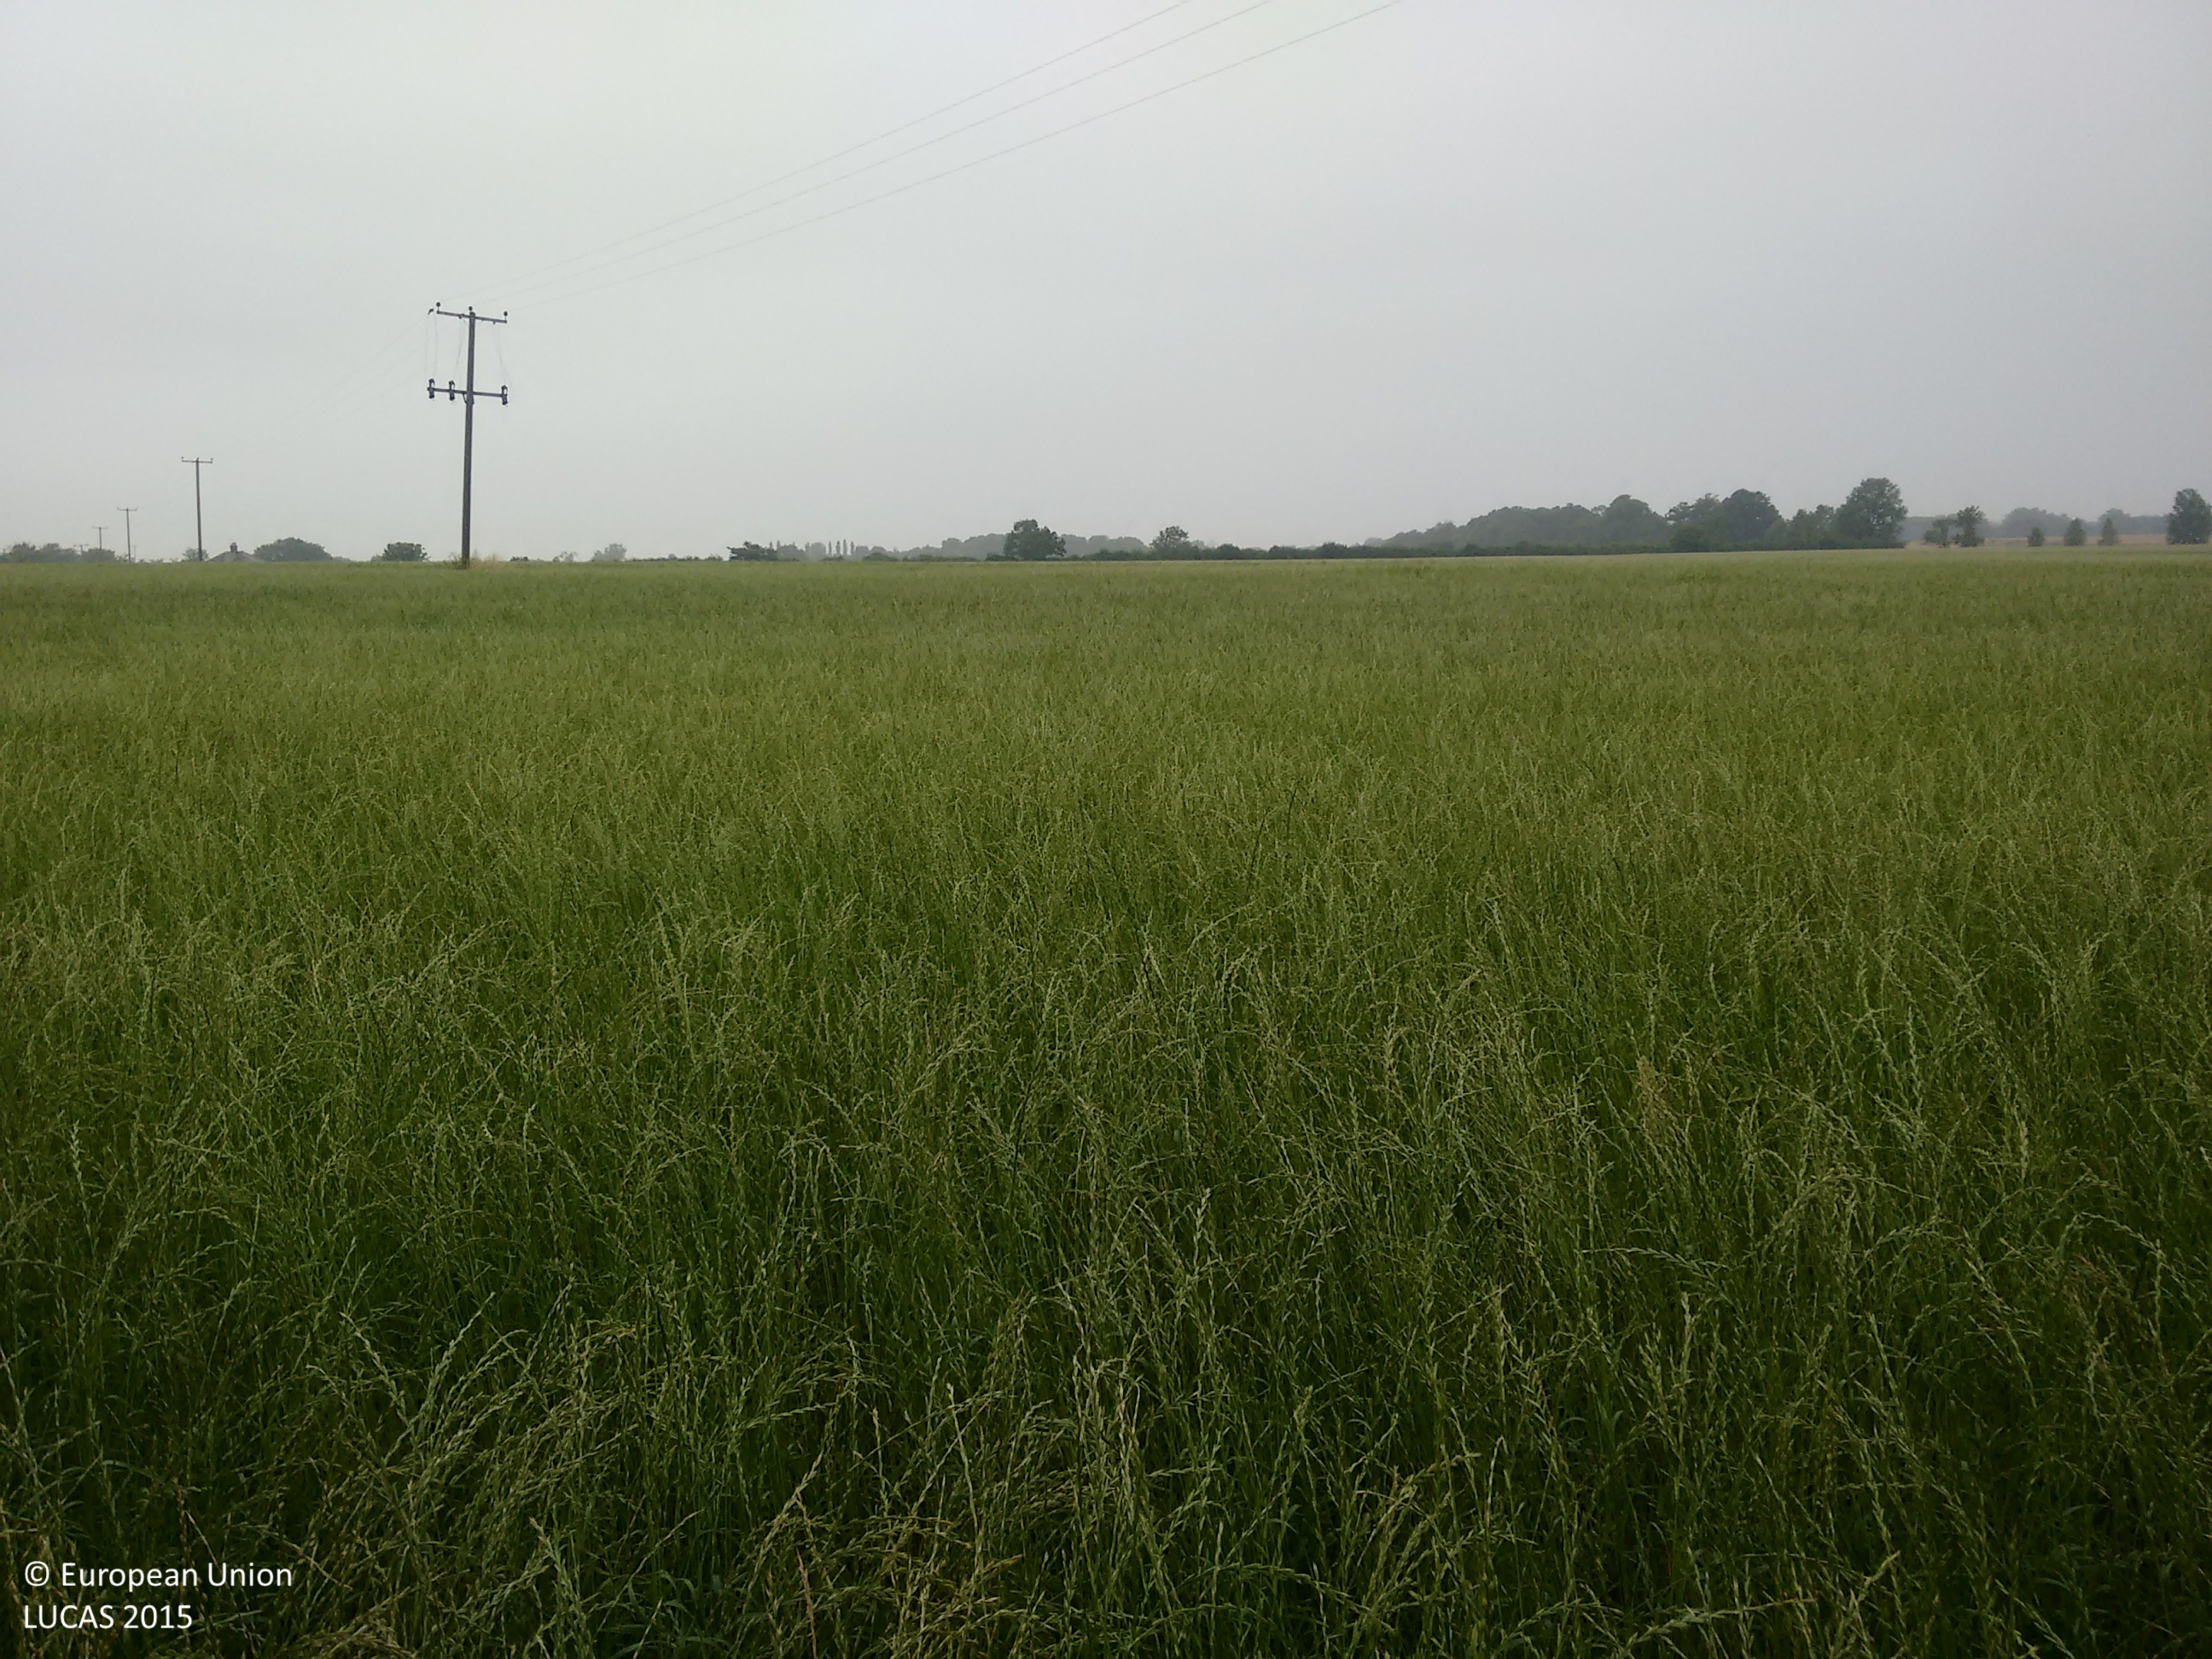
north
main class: Cropland
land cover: Temporary grasslands
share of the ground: > 75 %
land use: Agriculture (excluding fallow land and kitchen gardens)
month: July
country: GB
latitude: 51.7495
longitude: 0.3674
